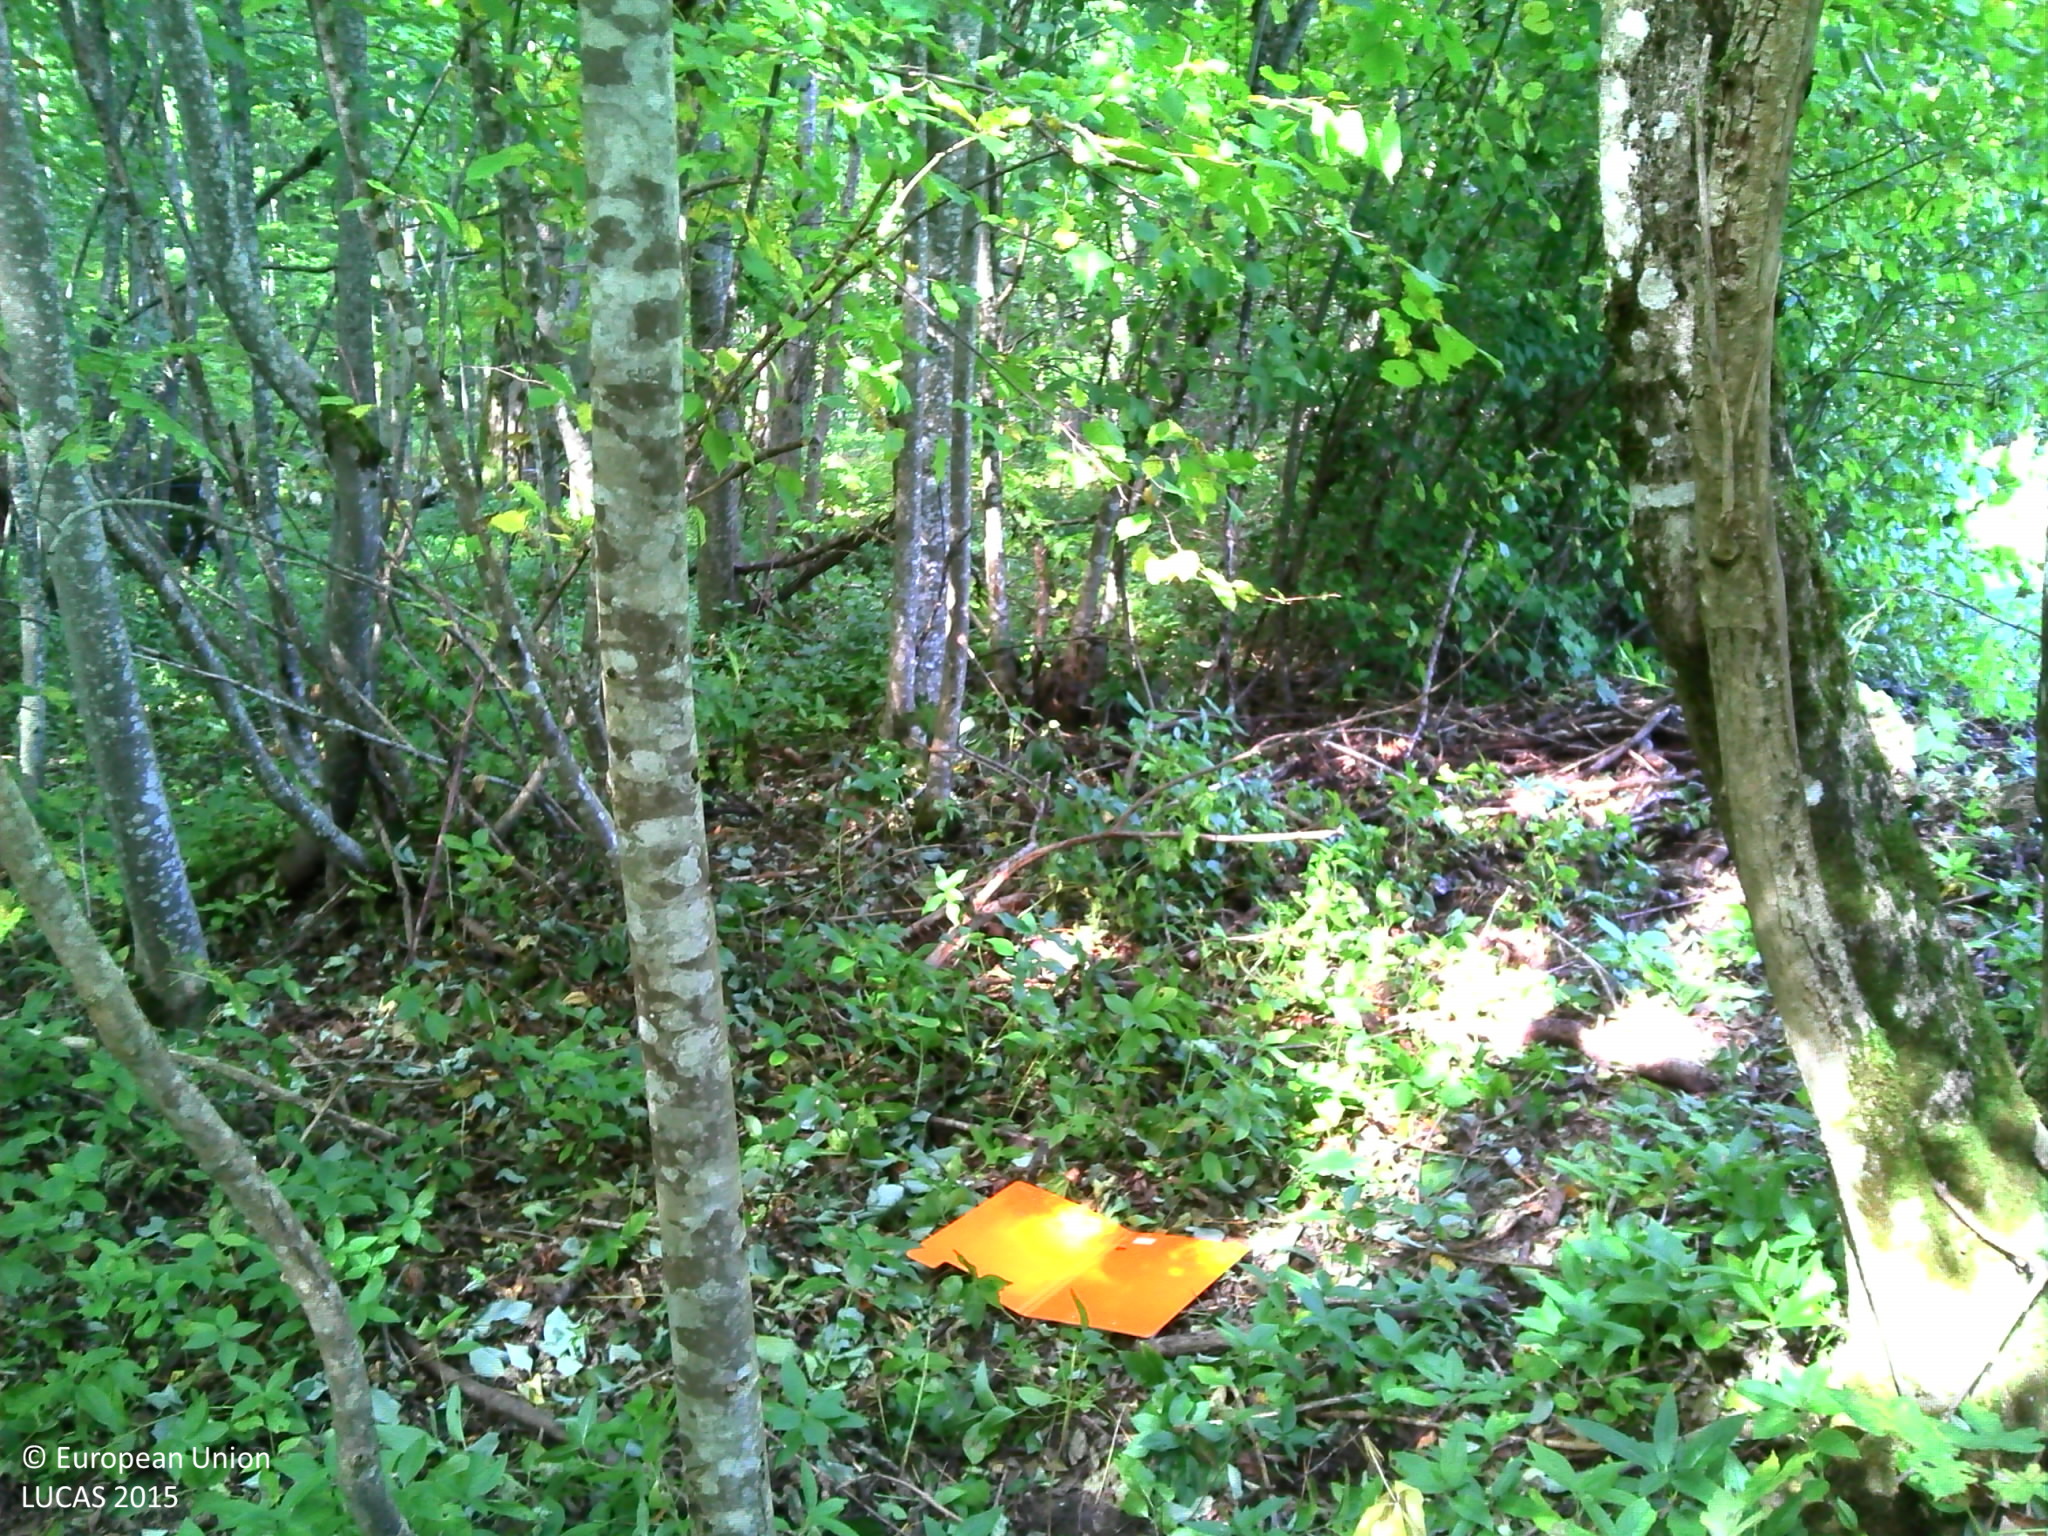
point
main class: Woodland
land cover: Broadleaved woodland
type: mesophytic deciduous forest
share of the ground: > 75 %
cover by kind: broadleaved forest trees 90 %, herbaceous plants 10 %
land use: Forestry
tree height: > 5 m
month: October
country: FR
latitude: 47.0112
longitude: 6.3849
